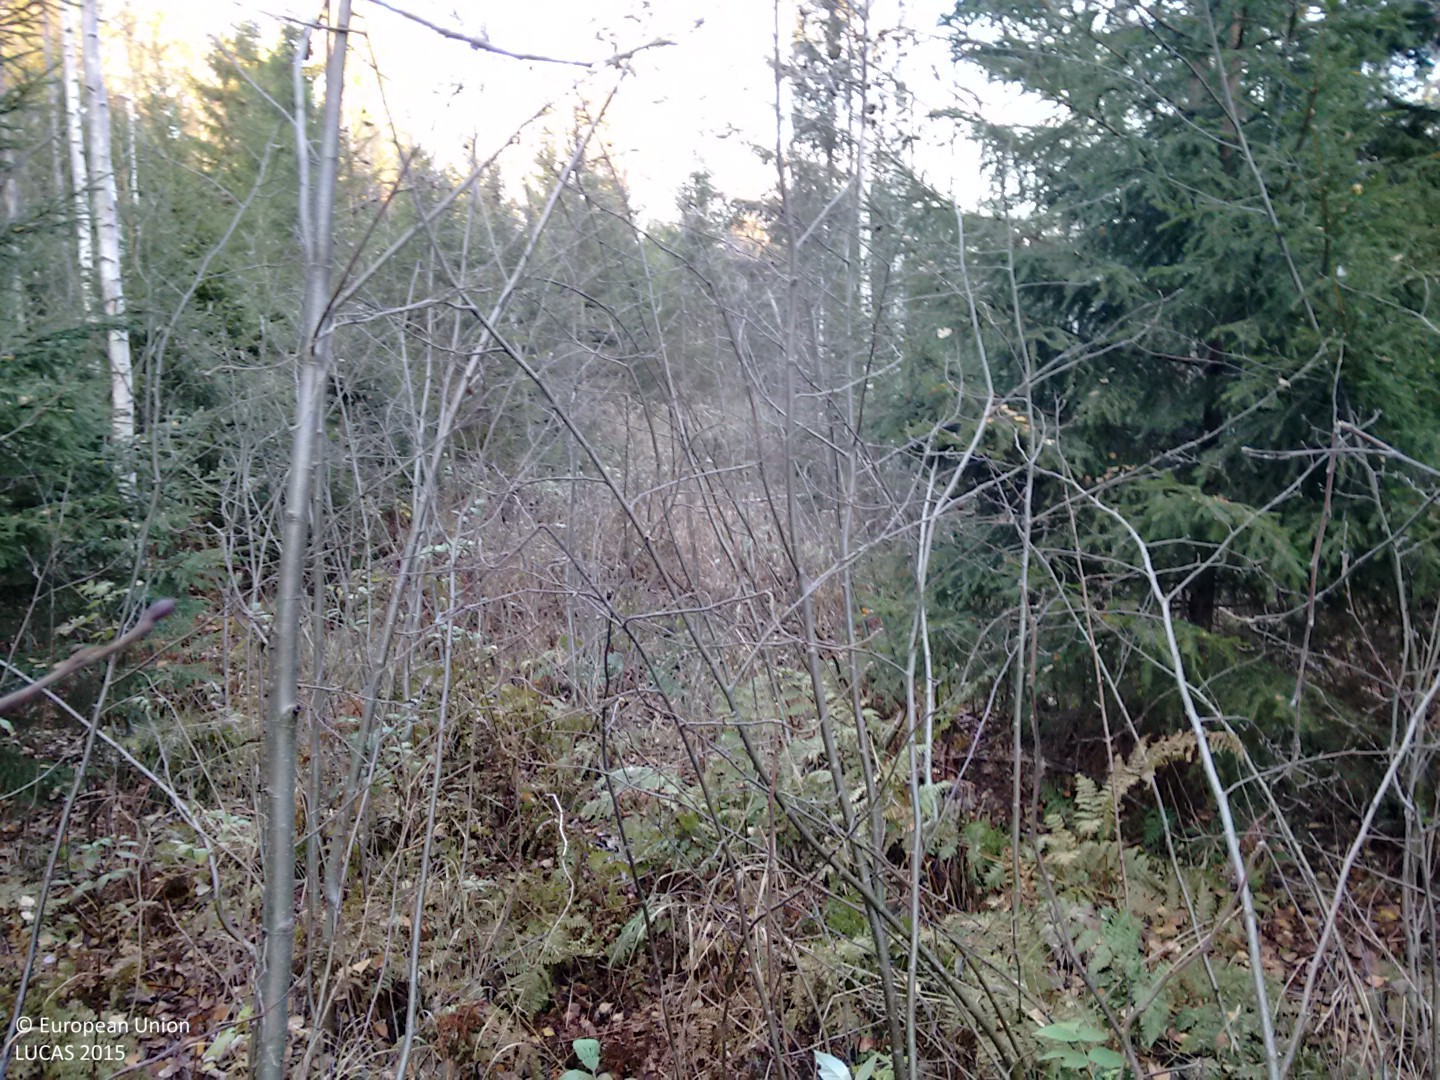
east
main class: Woodland
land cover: Spruce dominated mixed woodland
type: boreal forest
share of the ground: > 75 %
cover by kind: broadleaved forest trees 45 %, coniferous forest trees 40 %, shrubs 10 %, herbaceous plants 5 %
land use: Forestry
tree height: > 5 m
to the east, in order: Spruce dominated mixed woodland; Broadleaved woodland; Spruce dominated mixed woodland
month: October
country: FI
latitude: 62.8430
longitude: 26.1292
